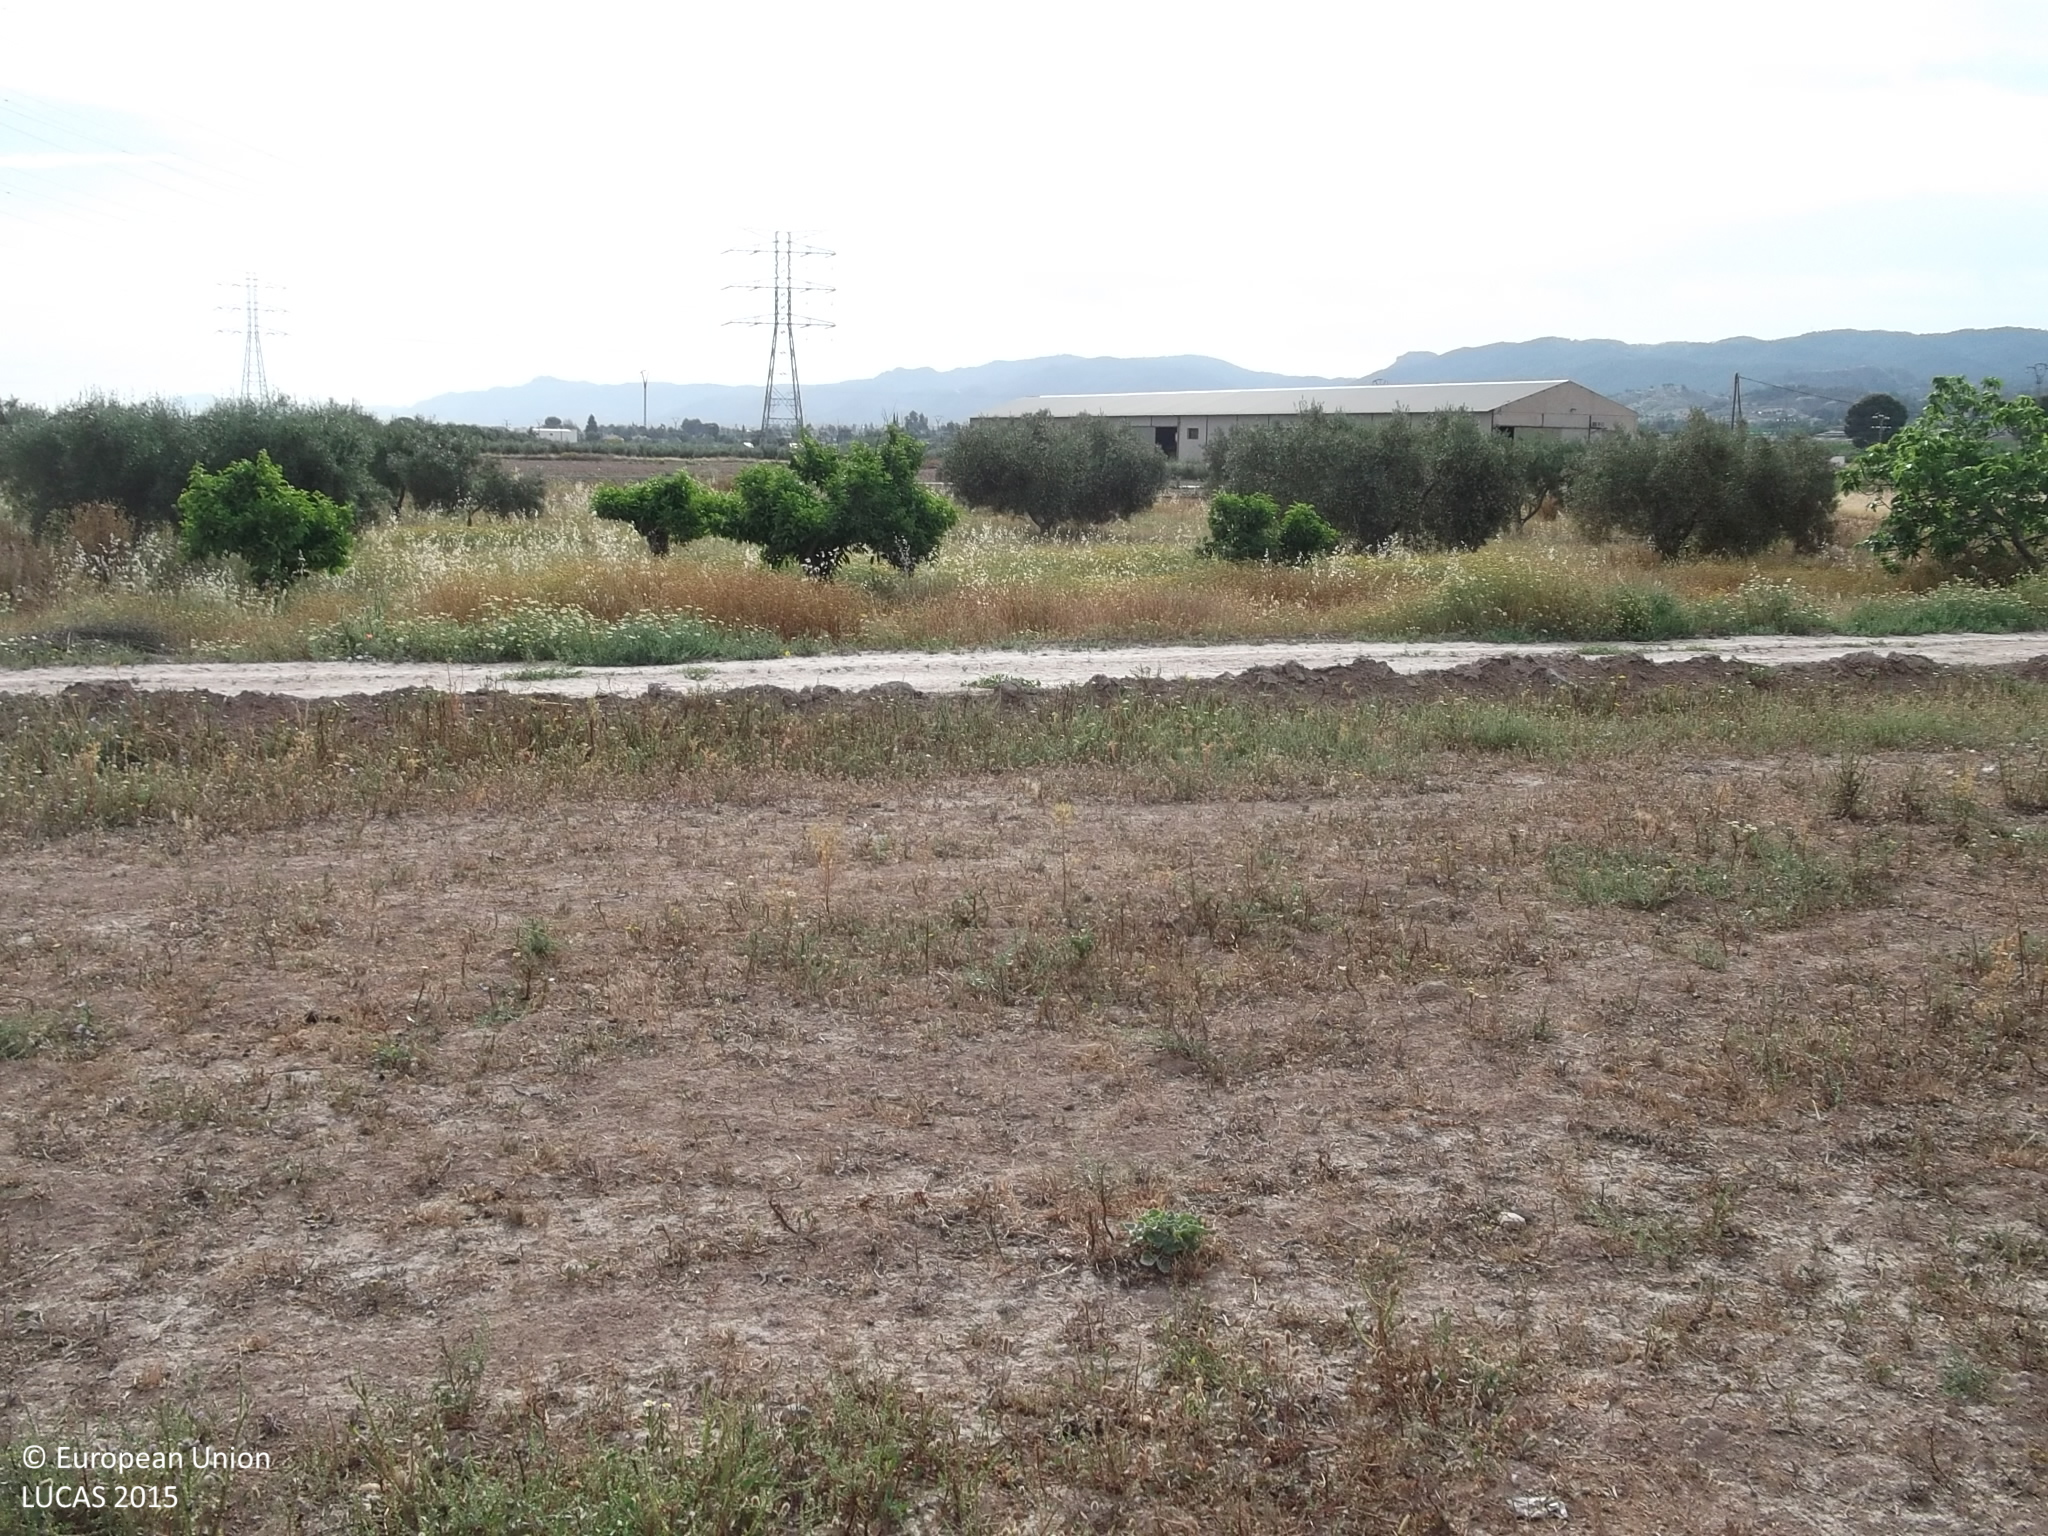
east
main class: Grassland
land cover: Spontaneously vegetated surfaces
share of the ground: 50 - 75 %
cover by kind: herbaceous plants 60 %, unconsolidated bare surface 40 %
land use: Abandoned areas
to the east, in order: Spontaneously vegetated surfaces; Grass margins; Tracks; Grass margins; Olive groves; Ditches and canals; Grass margins; Other bare soil; Grass margins; Paved roads, cycling and walking lanes; Grass margins; Tracks; Other bare soil; Artificial constructions in urban areas; Other bare soil
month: May
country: ES
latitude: 37.9183
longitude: -1.2565
